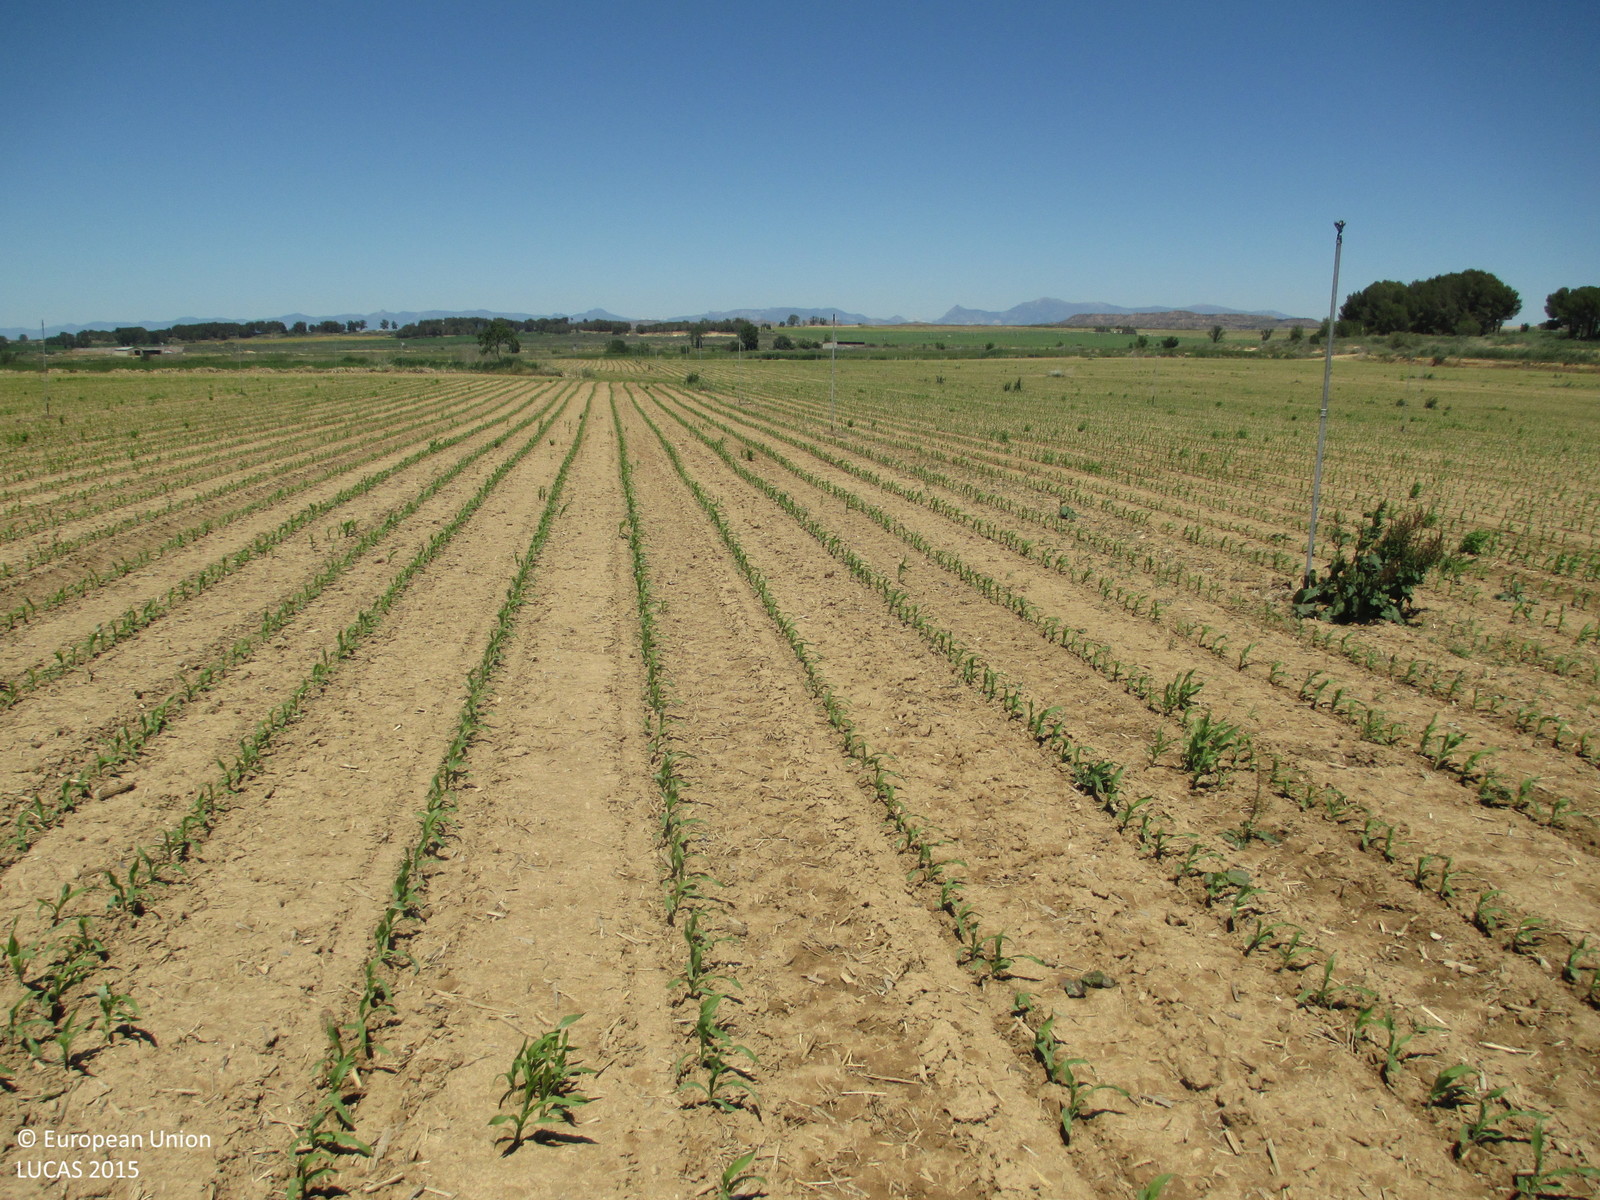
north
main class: Cropland
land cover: Maize
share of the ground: < 10 %
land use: Agriculture (excluding fallow land and kitchen gardens)
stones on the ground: < 10 %
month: May
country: ES
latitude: 41.9089
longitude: -0.3033
